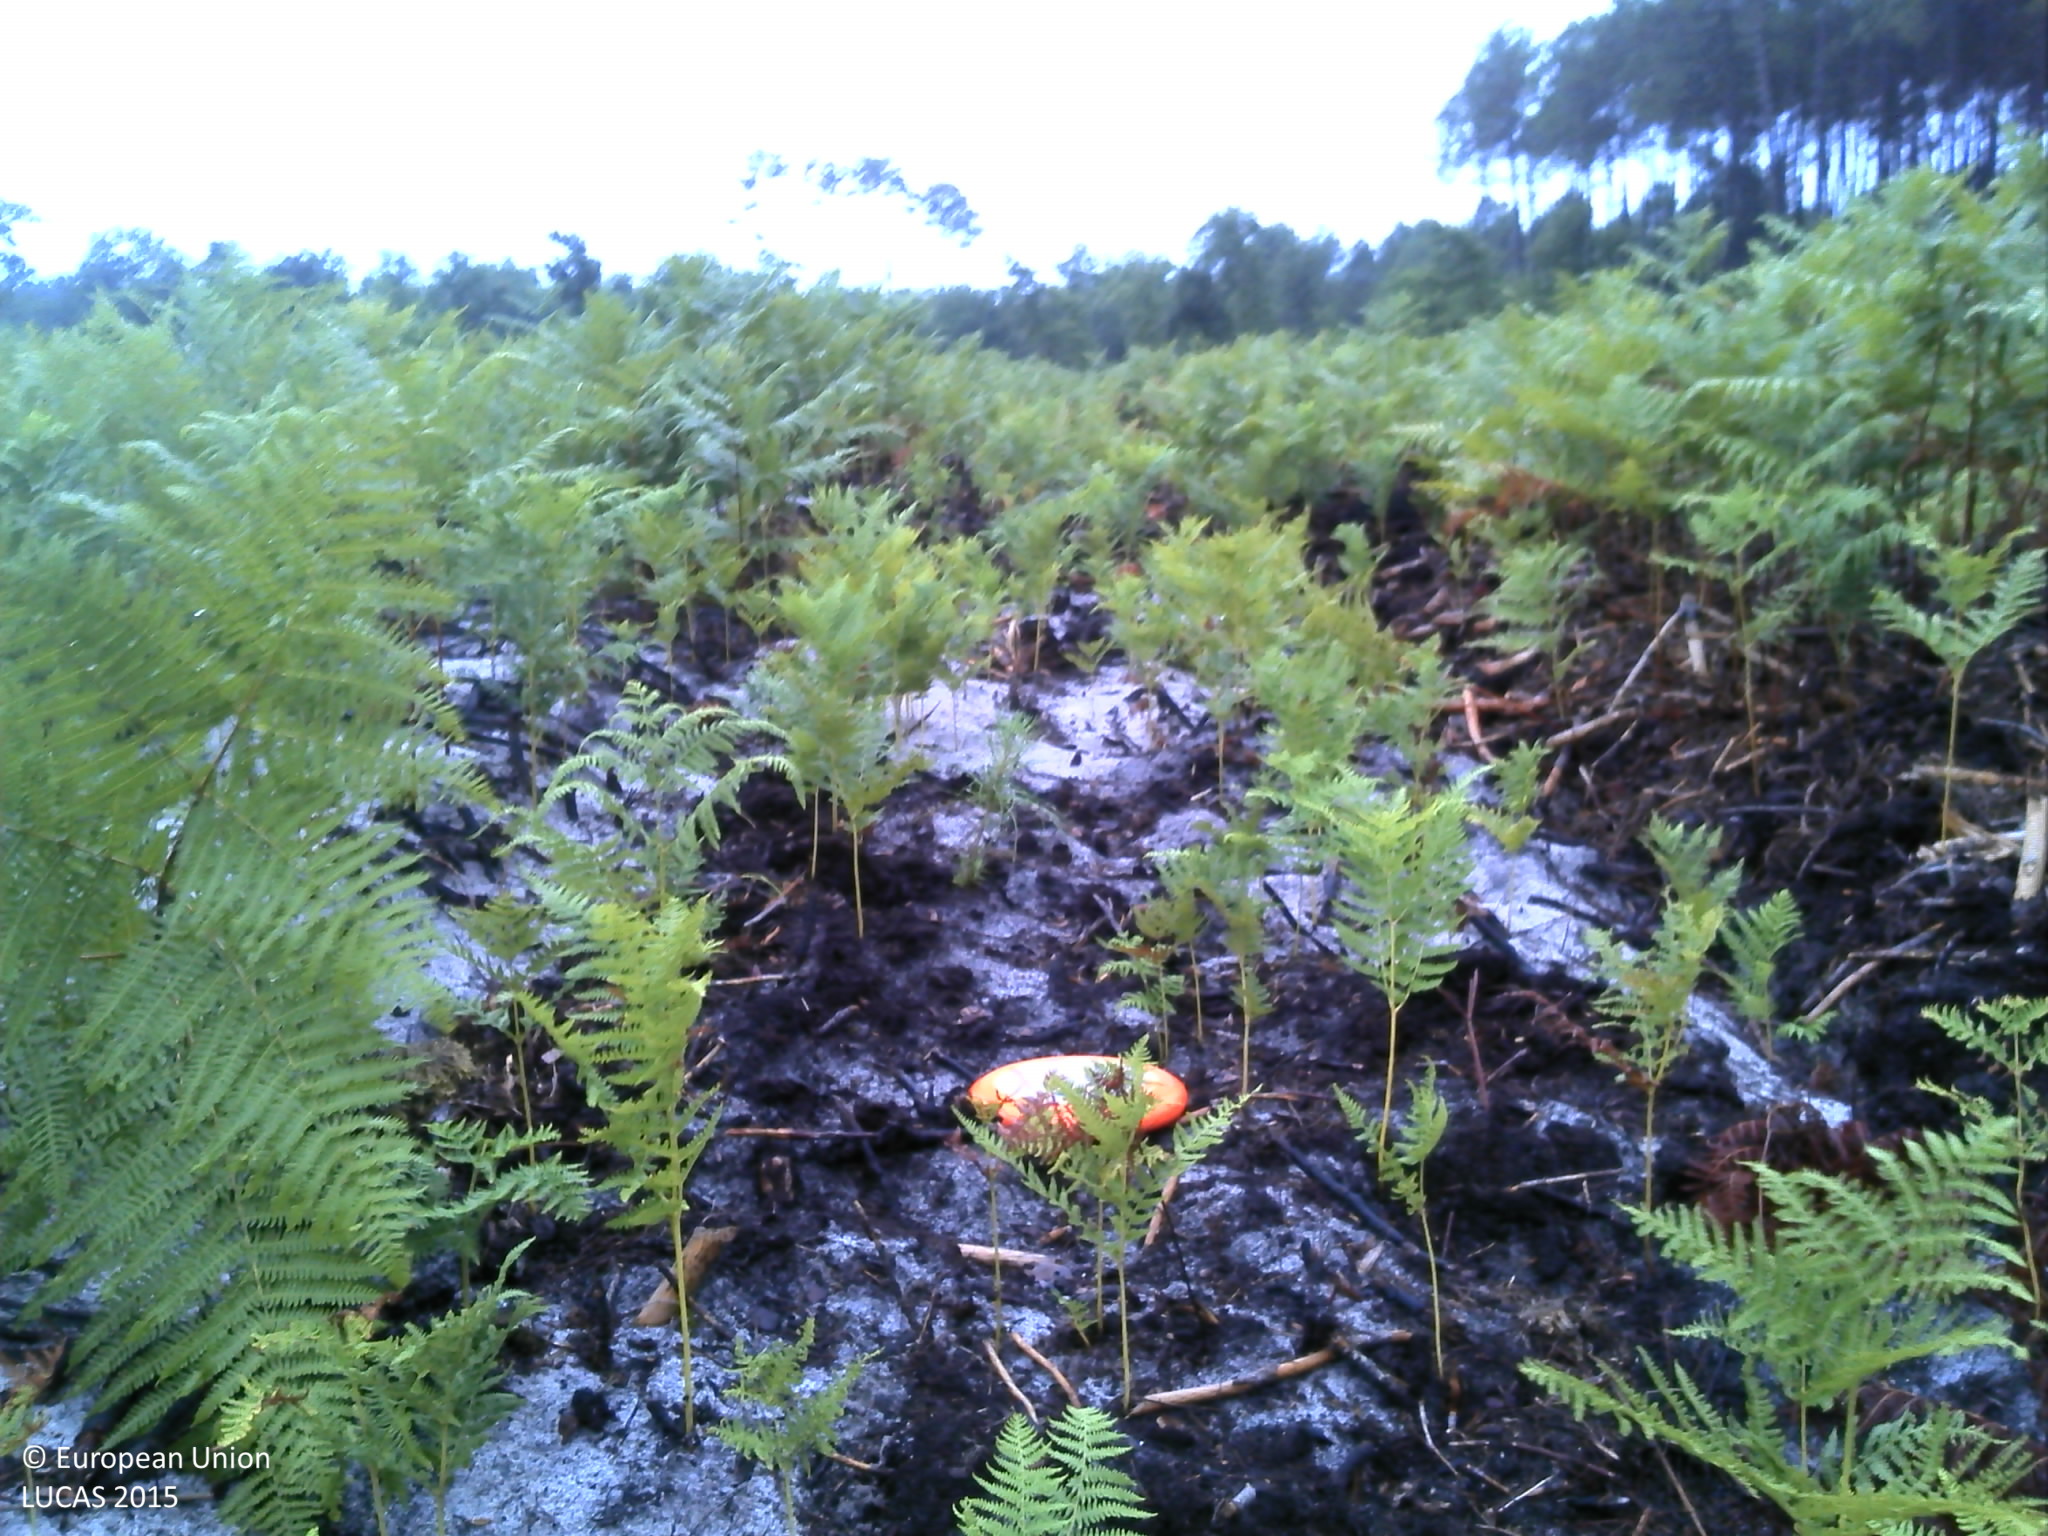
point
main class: Grassland
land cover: Spontaneously vegetated surfaces
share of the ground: > 75 %
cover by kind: herbaceous plants 90 %, shrubs 5 %, lichens and mosses 5 %
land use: Forestry
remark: Clear cut
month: August
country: FR
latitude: 44.5378
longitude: -0.9060
